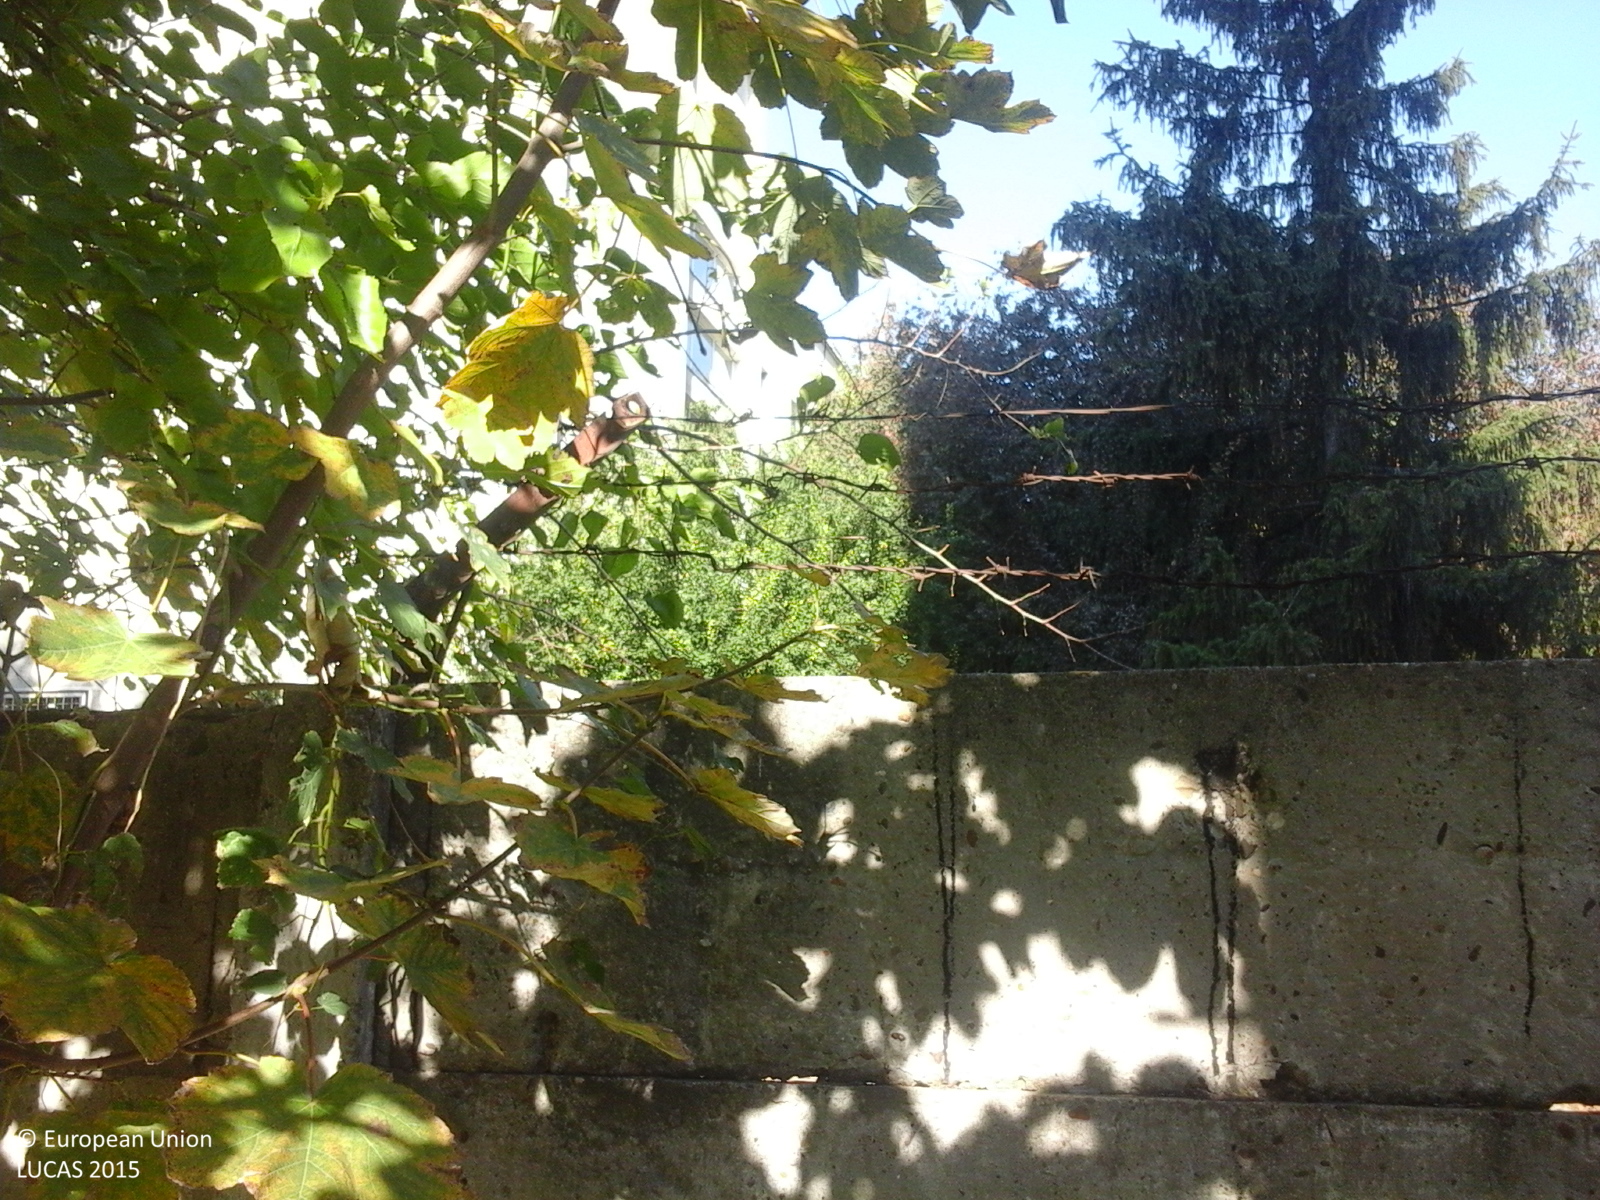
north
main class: Grassland
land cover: Spontaneously vegetated surfaces
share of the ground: > 75 %
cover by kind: herbaceous plants 60 %, consolidated bare surface 40 %
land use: Abandoned areas
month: October
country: RO
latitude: 45.6831
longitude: 27.1838
